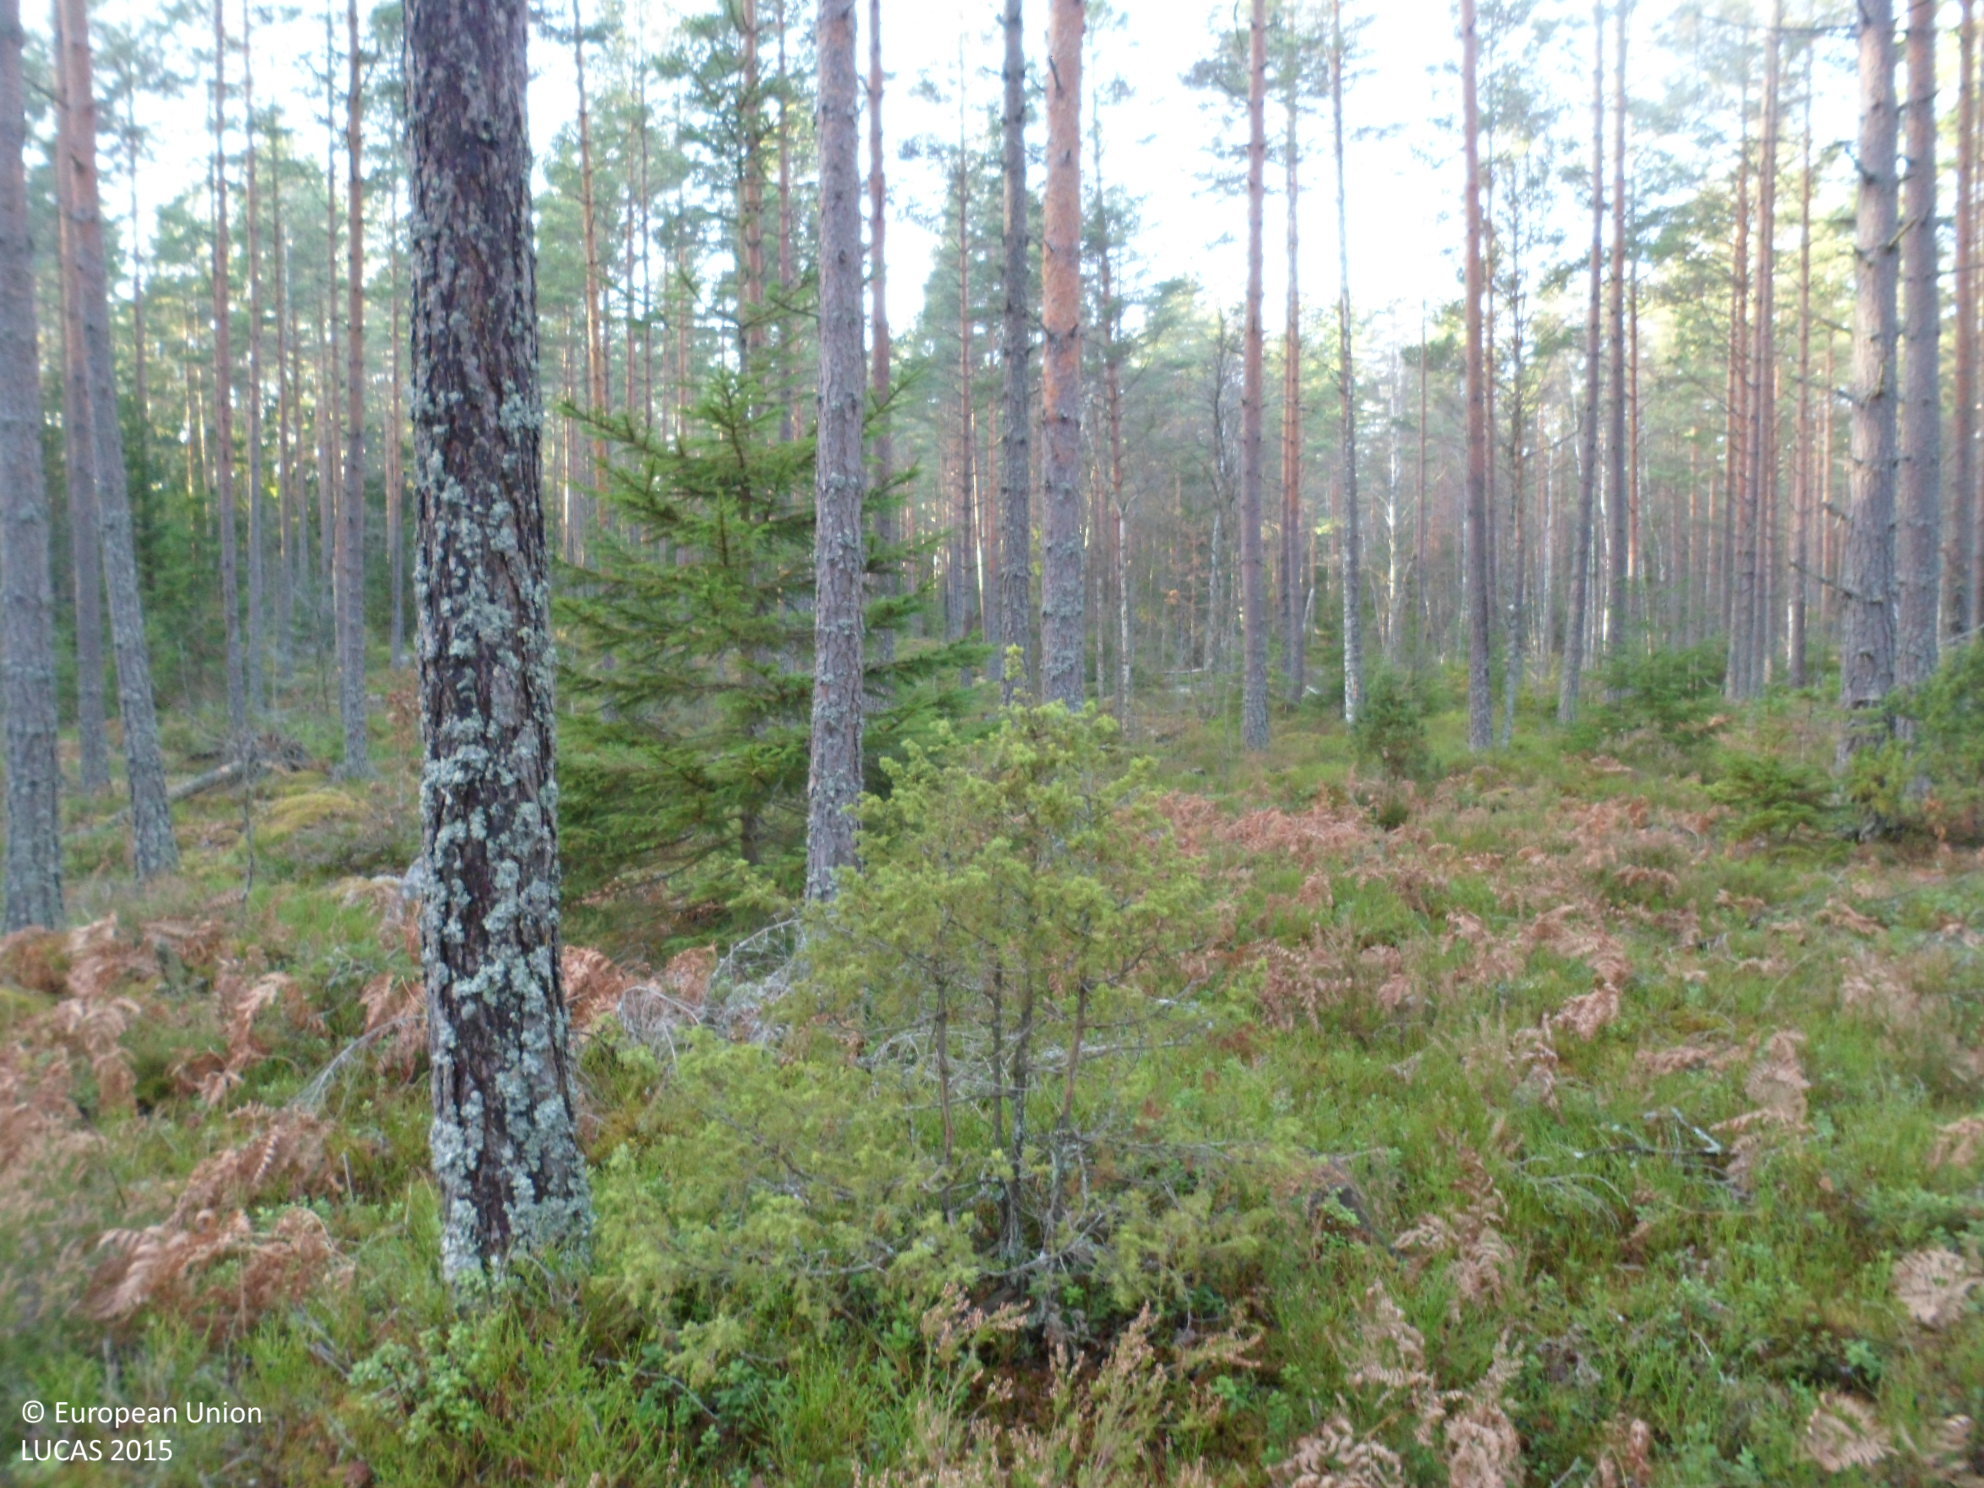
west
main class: Woodland
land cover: Pine dominated coniferous woodland
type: boreal forest
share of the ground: 25 - 50 %
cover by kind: coniferous forest trees 50 %, shrubs 25 %, lichens and mosses 25 %
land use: Forestry
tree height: > 5 m
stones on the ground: 25 - 50 %
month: November
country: SE
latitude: 56.8611
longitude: 15.9531
